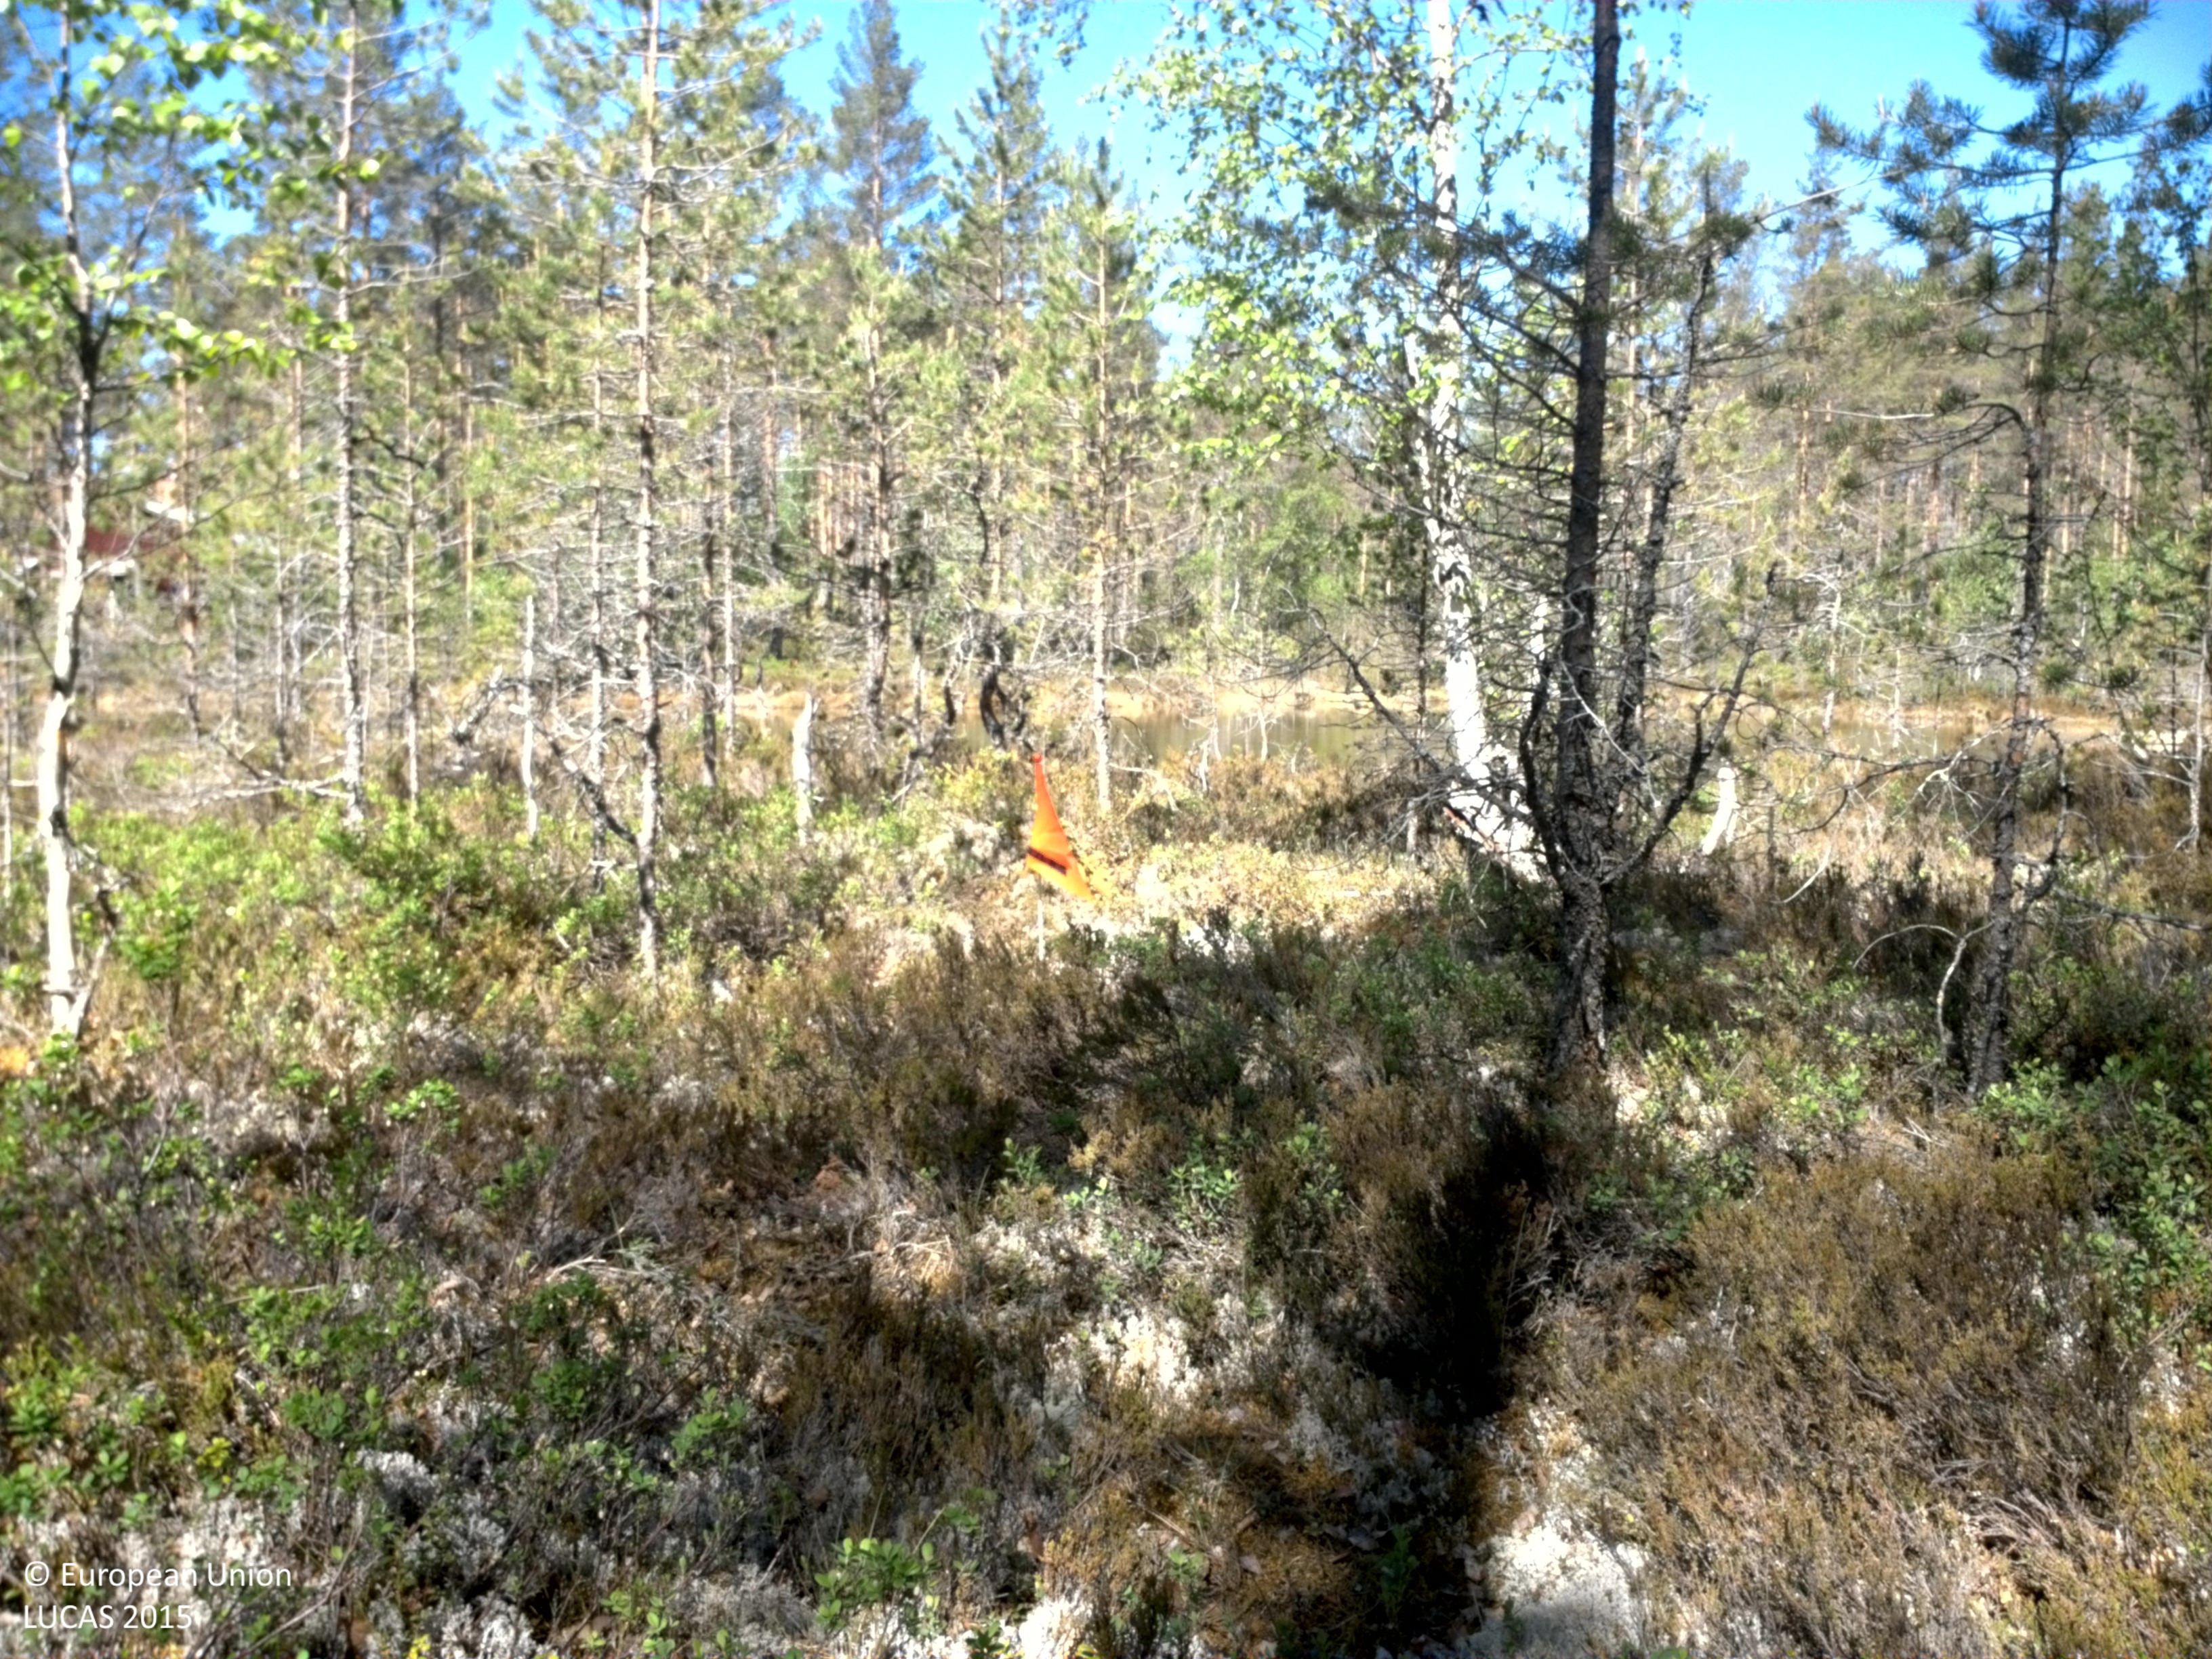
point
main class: Woodland
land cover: Pine dominated coniferous woodland
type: boreal forest
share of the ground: 50 - 75 %
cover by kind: coniferous forest trees 50 %, broadleaved forest trees 15 %, shrubs 15 %, herbaceous plants 15 %, lichens and mosses 5 %
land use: Forestry
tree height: < 5 m
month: June
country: SE
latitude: 61.3228
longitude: 13.6674
